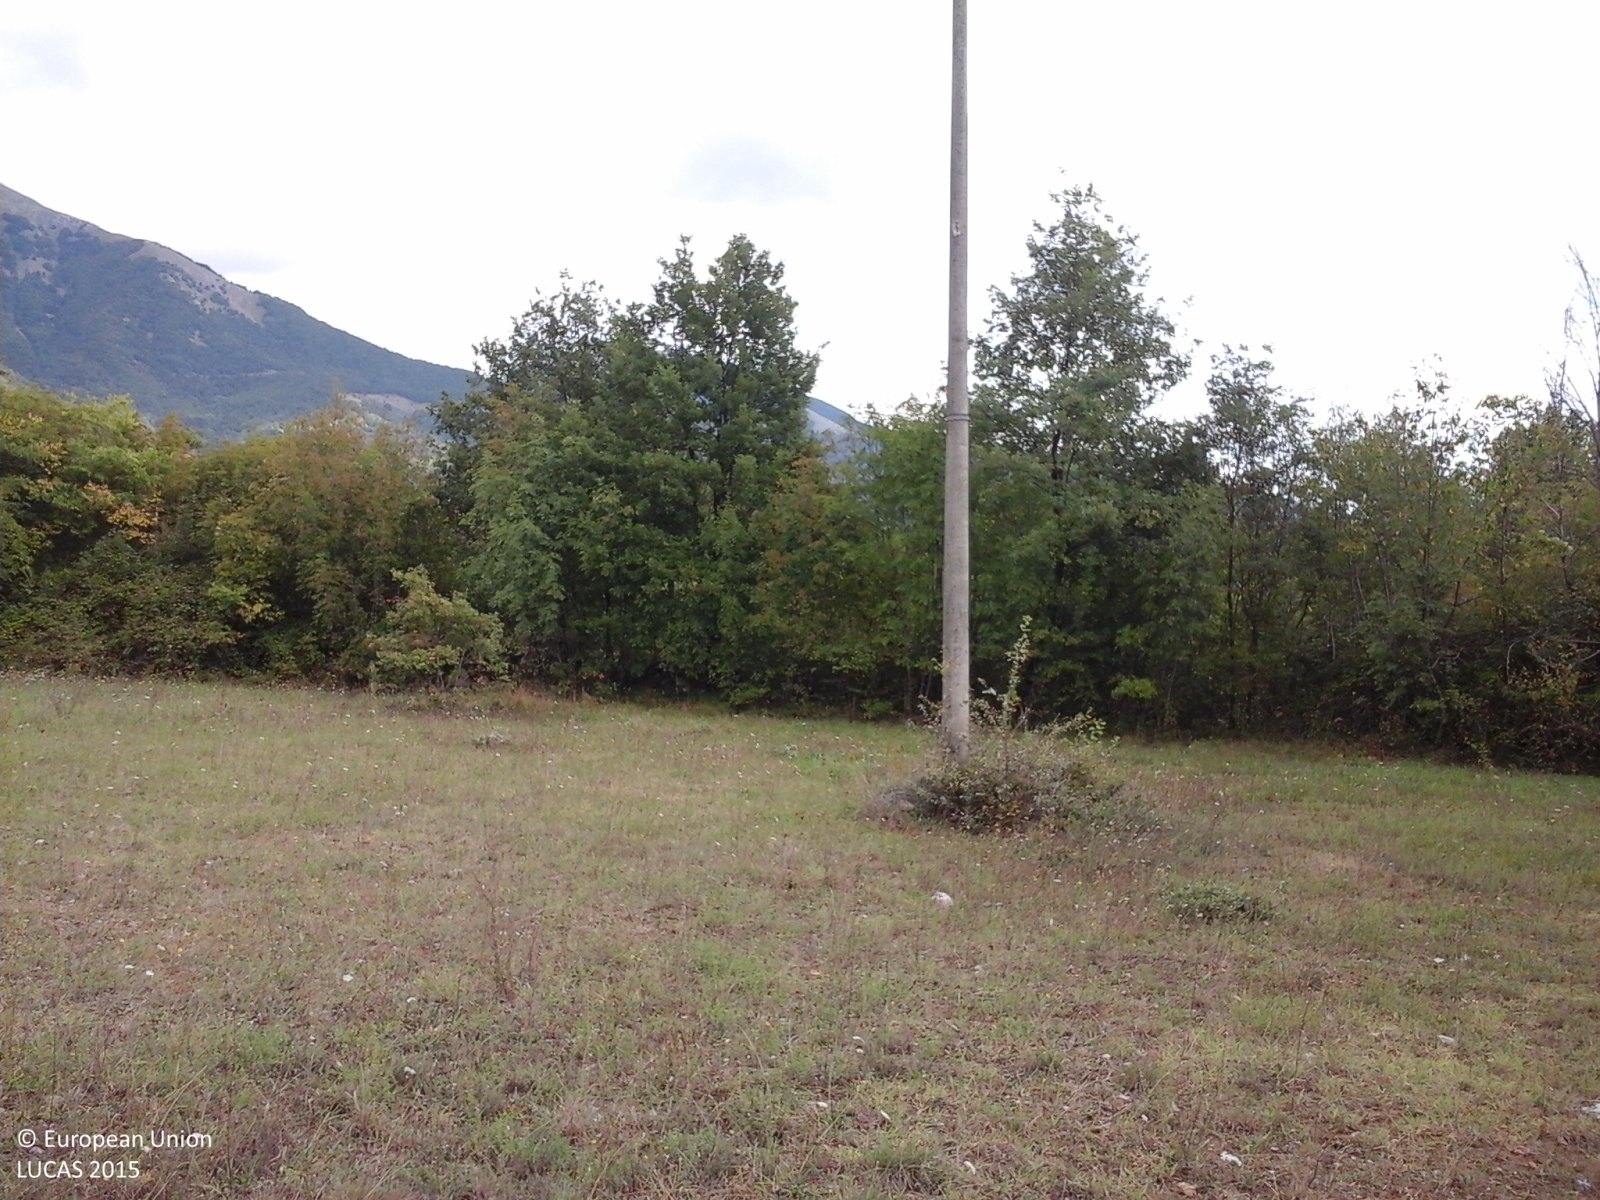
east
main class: Grassland
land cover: Grassland without tree/shrub cover
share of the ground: > 75 %
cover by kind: herbaceous plants 100 %
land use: Agriculture (excluding fallow land and kitchen gardens)
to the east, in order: Grassland without tree/shrub cover; Electric lines; Grassland without tree/shrub cover; Dry stone walls; Abandoned hedges; Grassland without tree/shrub cover; Broadleaved woodland; Grassland without tree/shrub cover; Abandoned hedges; Fences; Grassland without tree/shrub cover; Artificial constructions in urban areas; Other bare soil; Nuts trees; Abandoned hedges
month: September
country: IT
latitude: 41.6967
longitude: 13.7953
